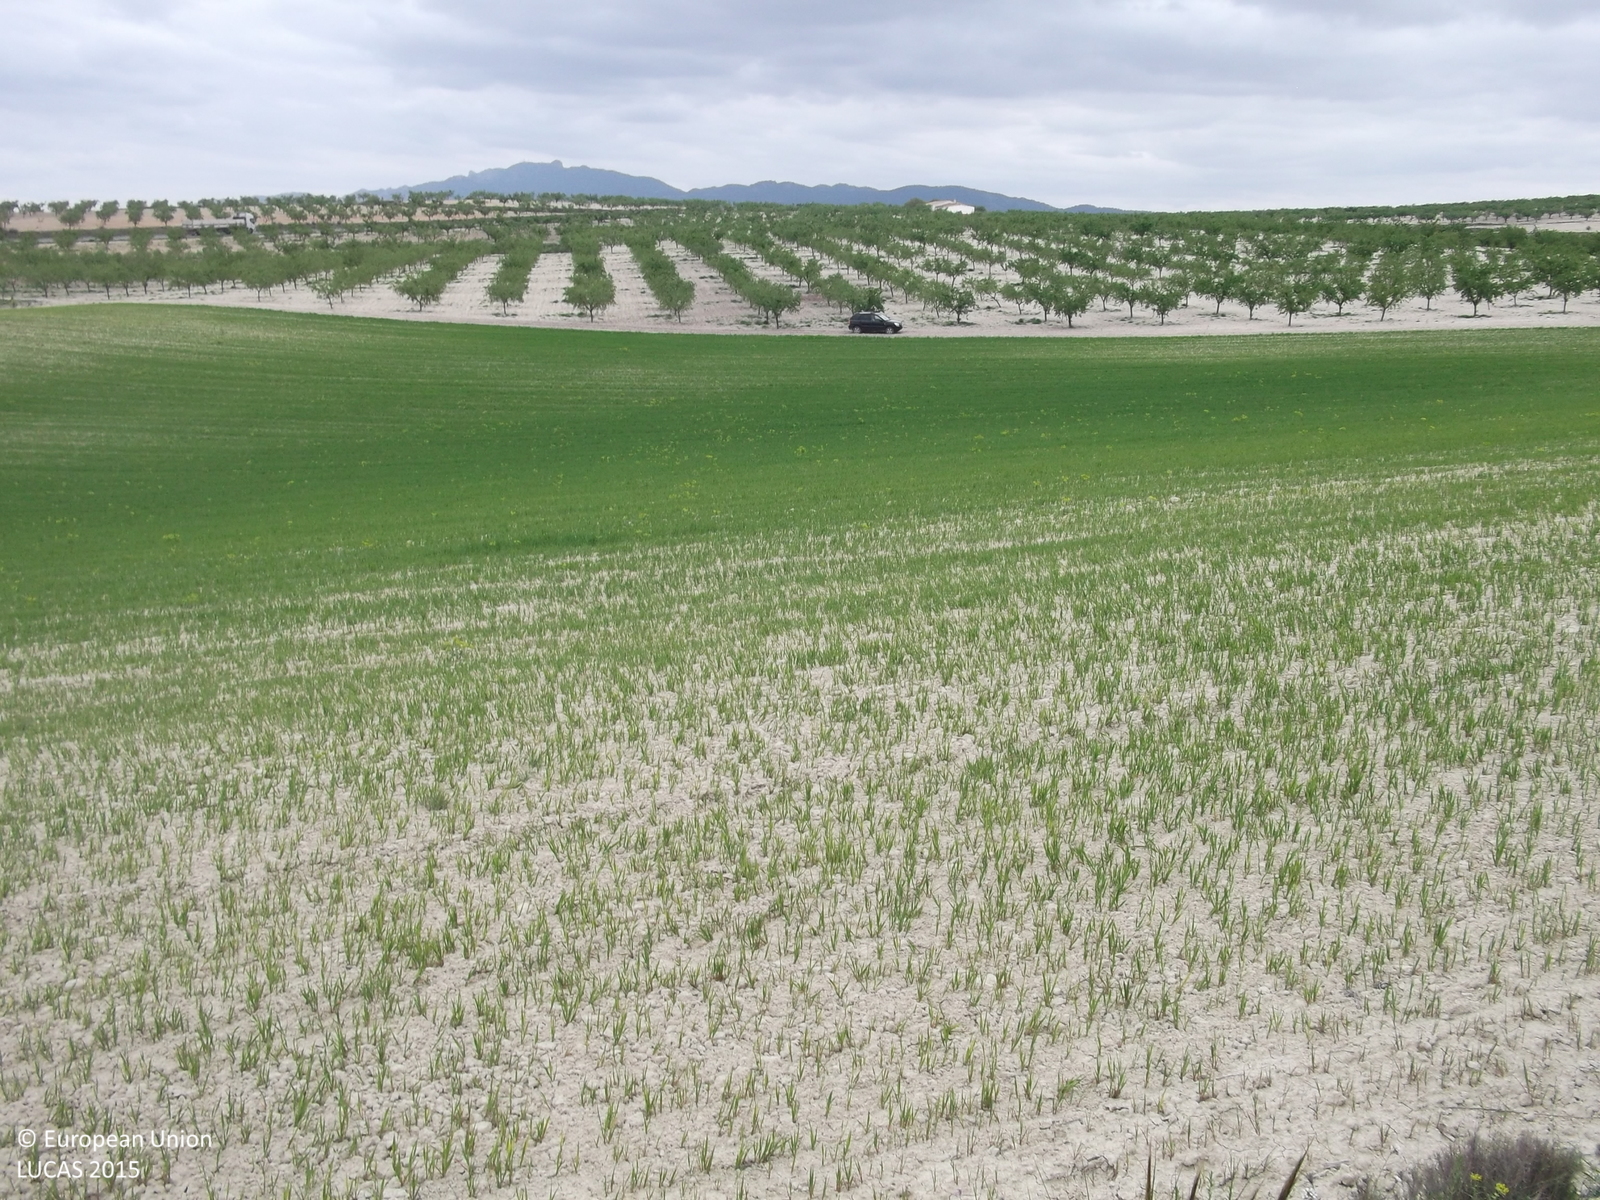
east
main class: Shrubland
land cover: Shrubland without tree cover
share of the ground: 50 - 75 %
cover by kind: shrubs 50 %, herbaceous plants 50 %
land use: Abandoned areas
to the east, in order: Shrubland without tree cover; Barley; Nuts trees
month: April
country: ES
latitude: 38.1341
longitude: -1.5908
